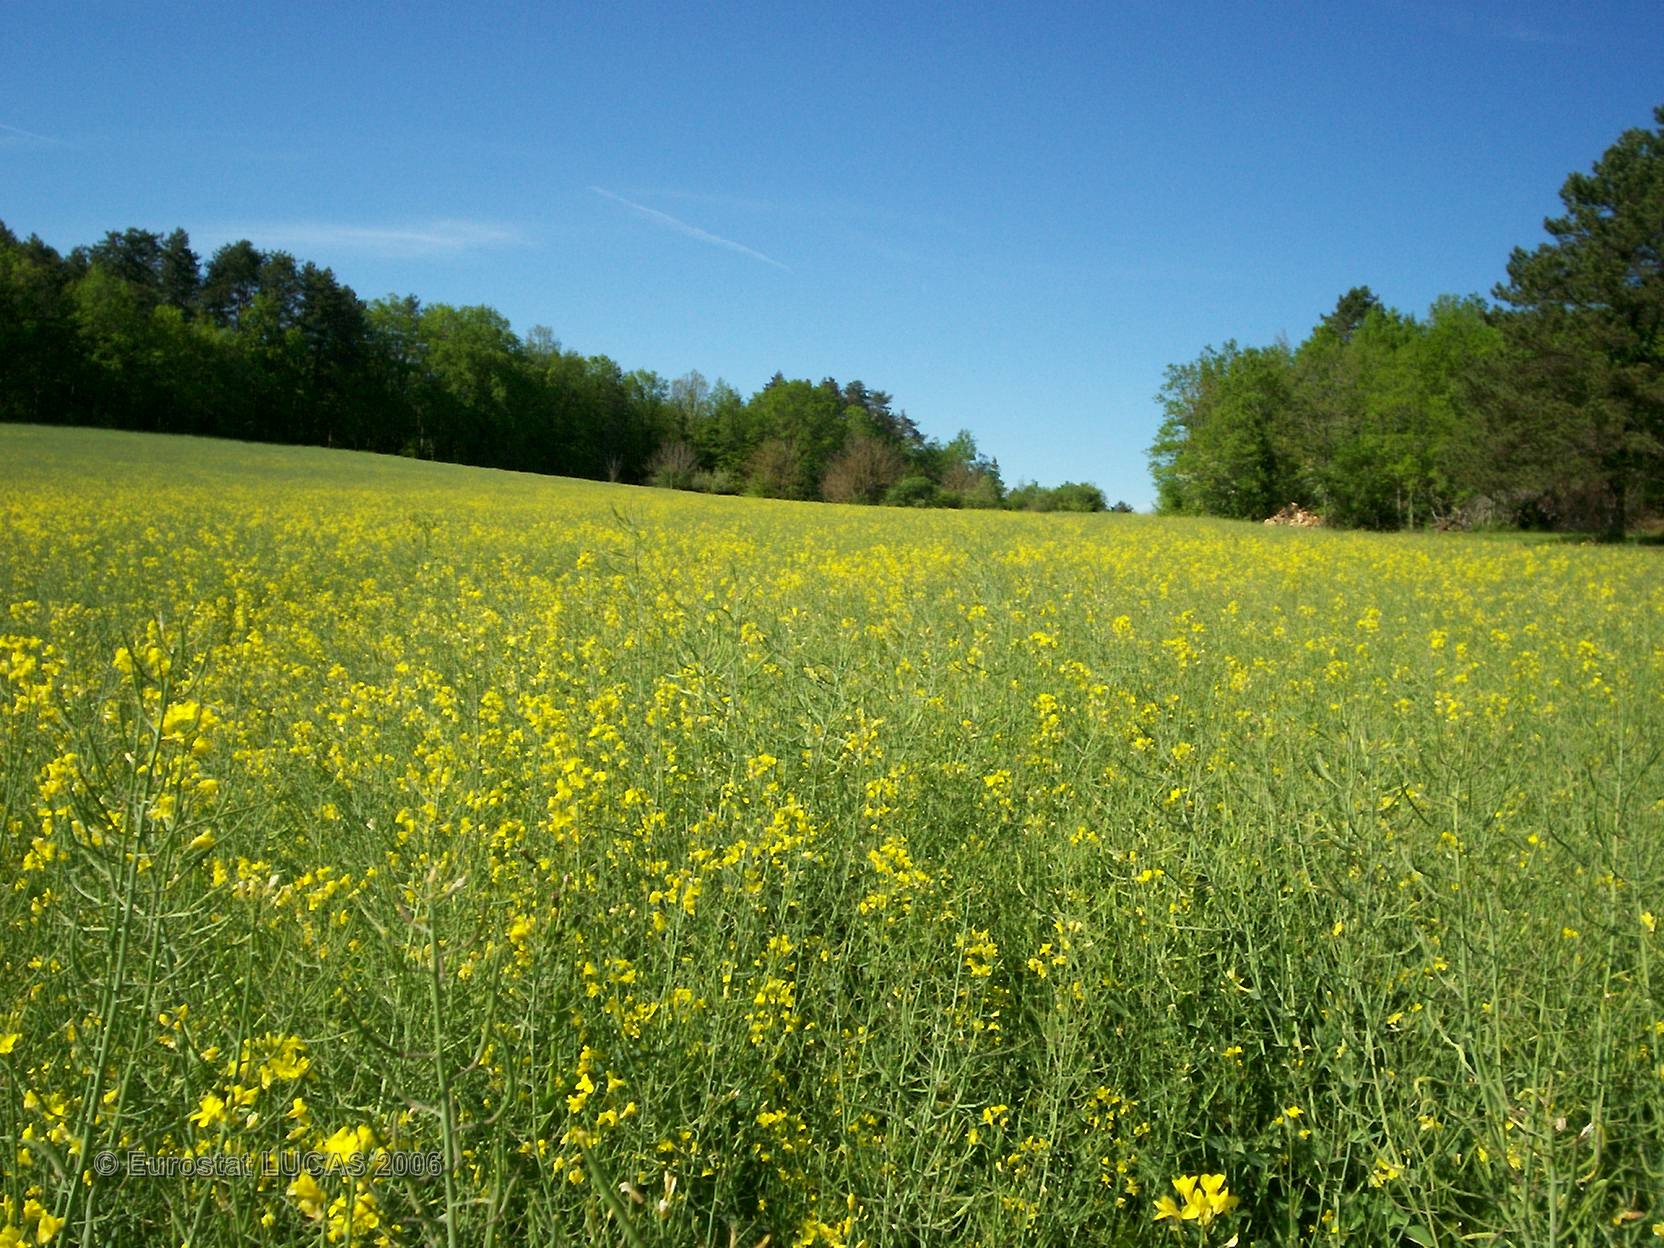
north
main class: Cropland
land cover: Rape and turnip rape
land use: Agriculture (excluding fallow land and kitchen gardens)
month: May
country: FR
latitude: 45.2697
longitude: 0.8519
